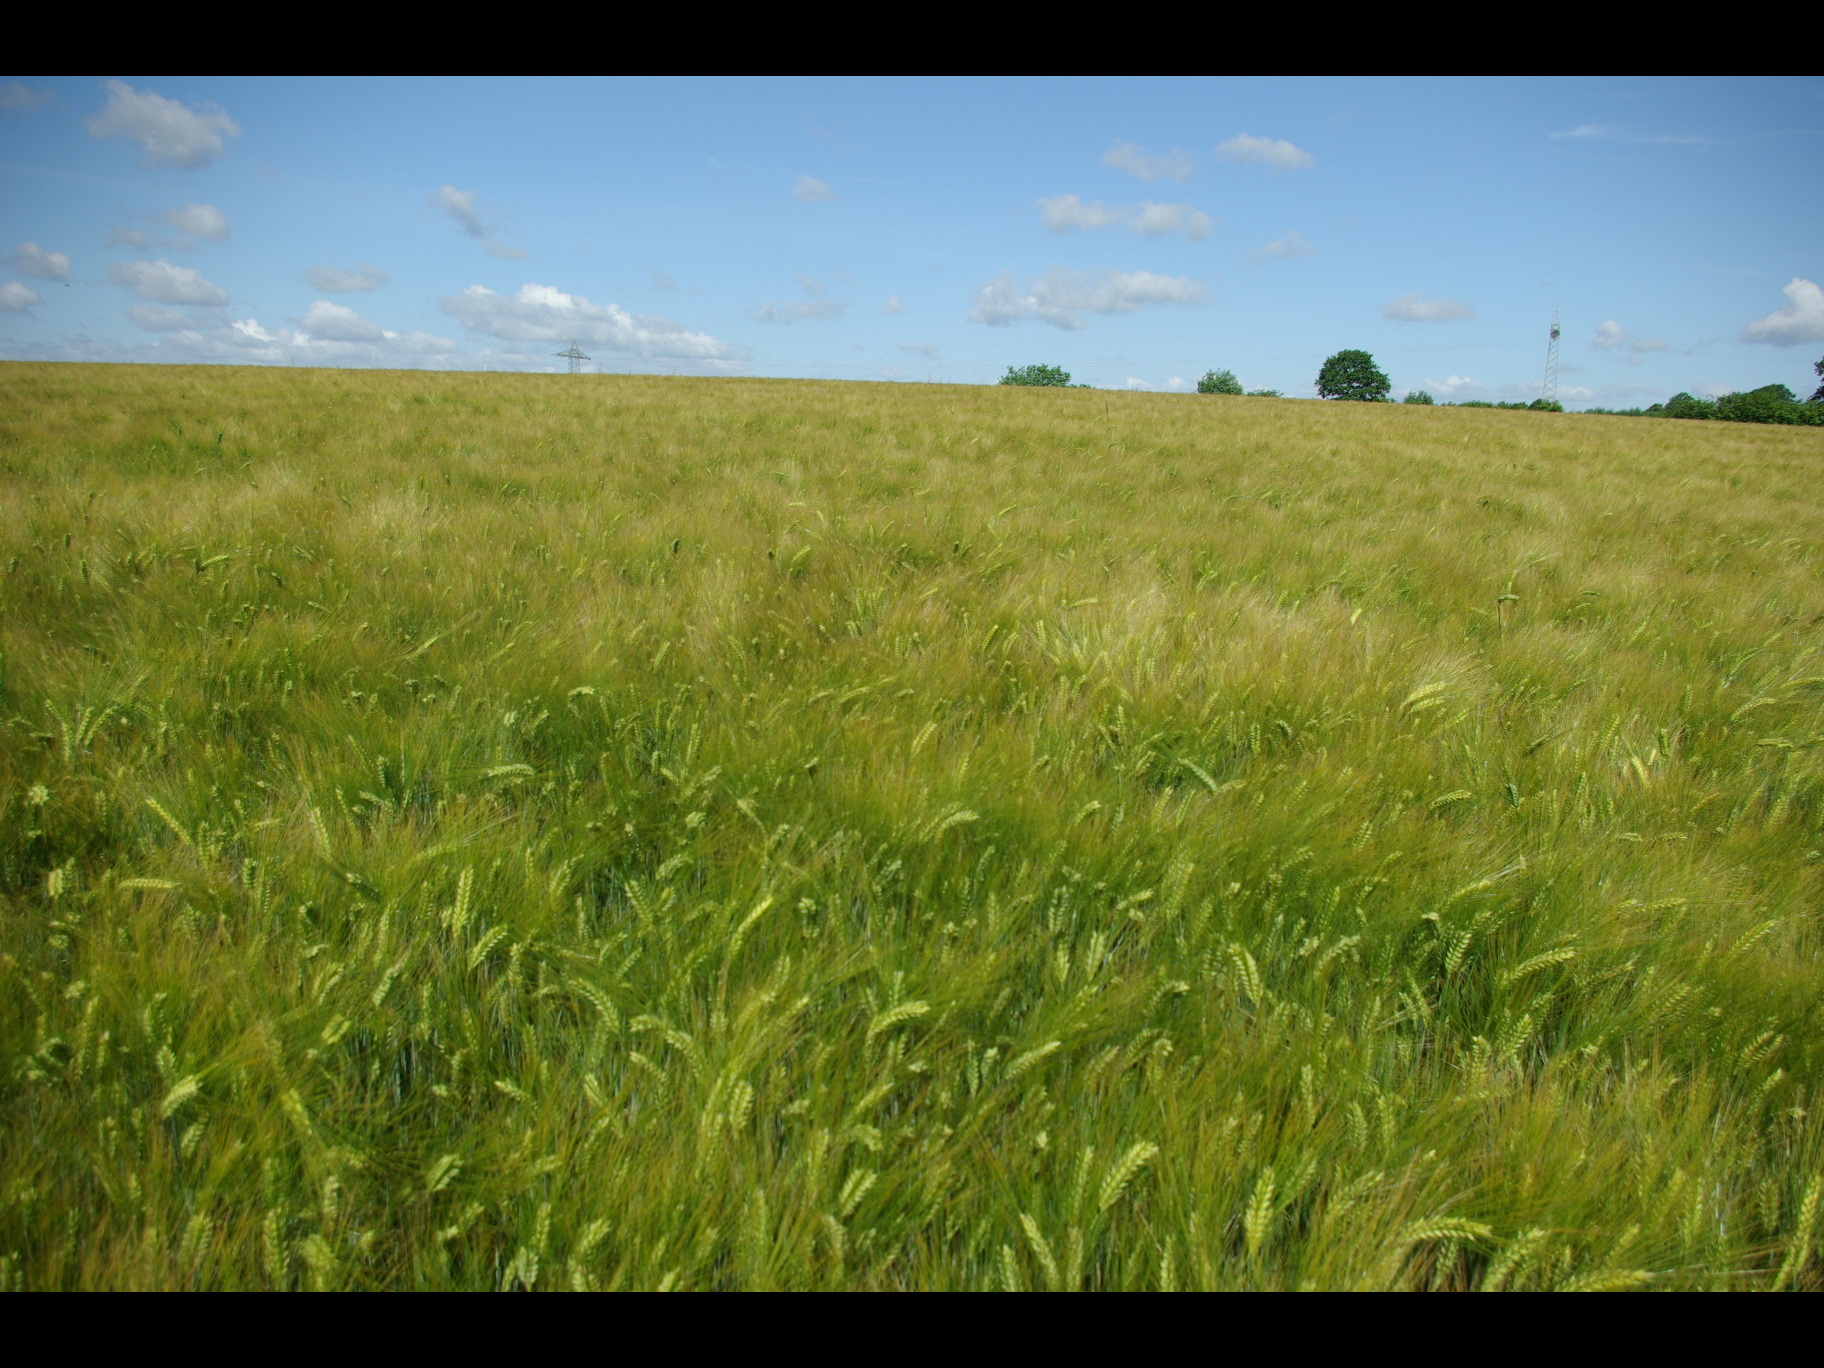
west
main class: Cropland
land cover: Barley
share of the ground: > 75 %
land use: Agriculture (excluding fallow land and kitchen gardens)
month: June
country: DE
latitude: 54.3544
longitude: 9.9231
